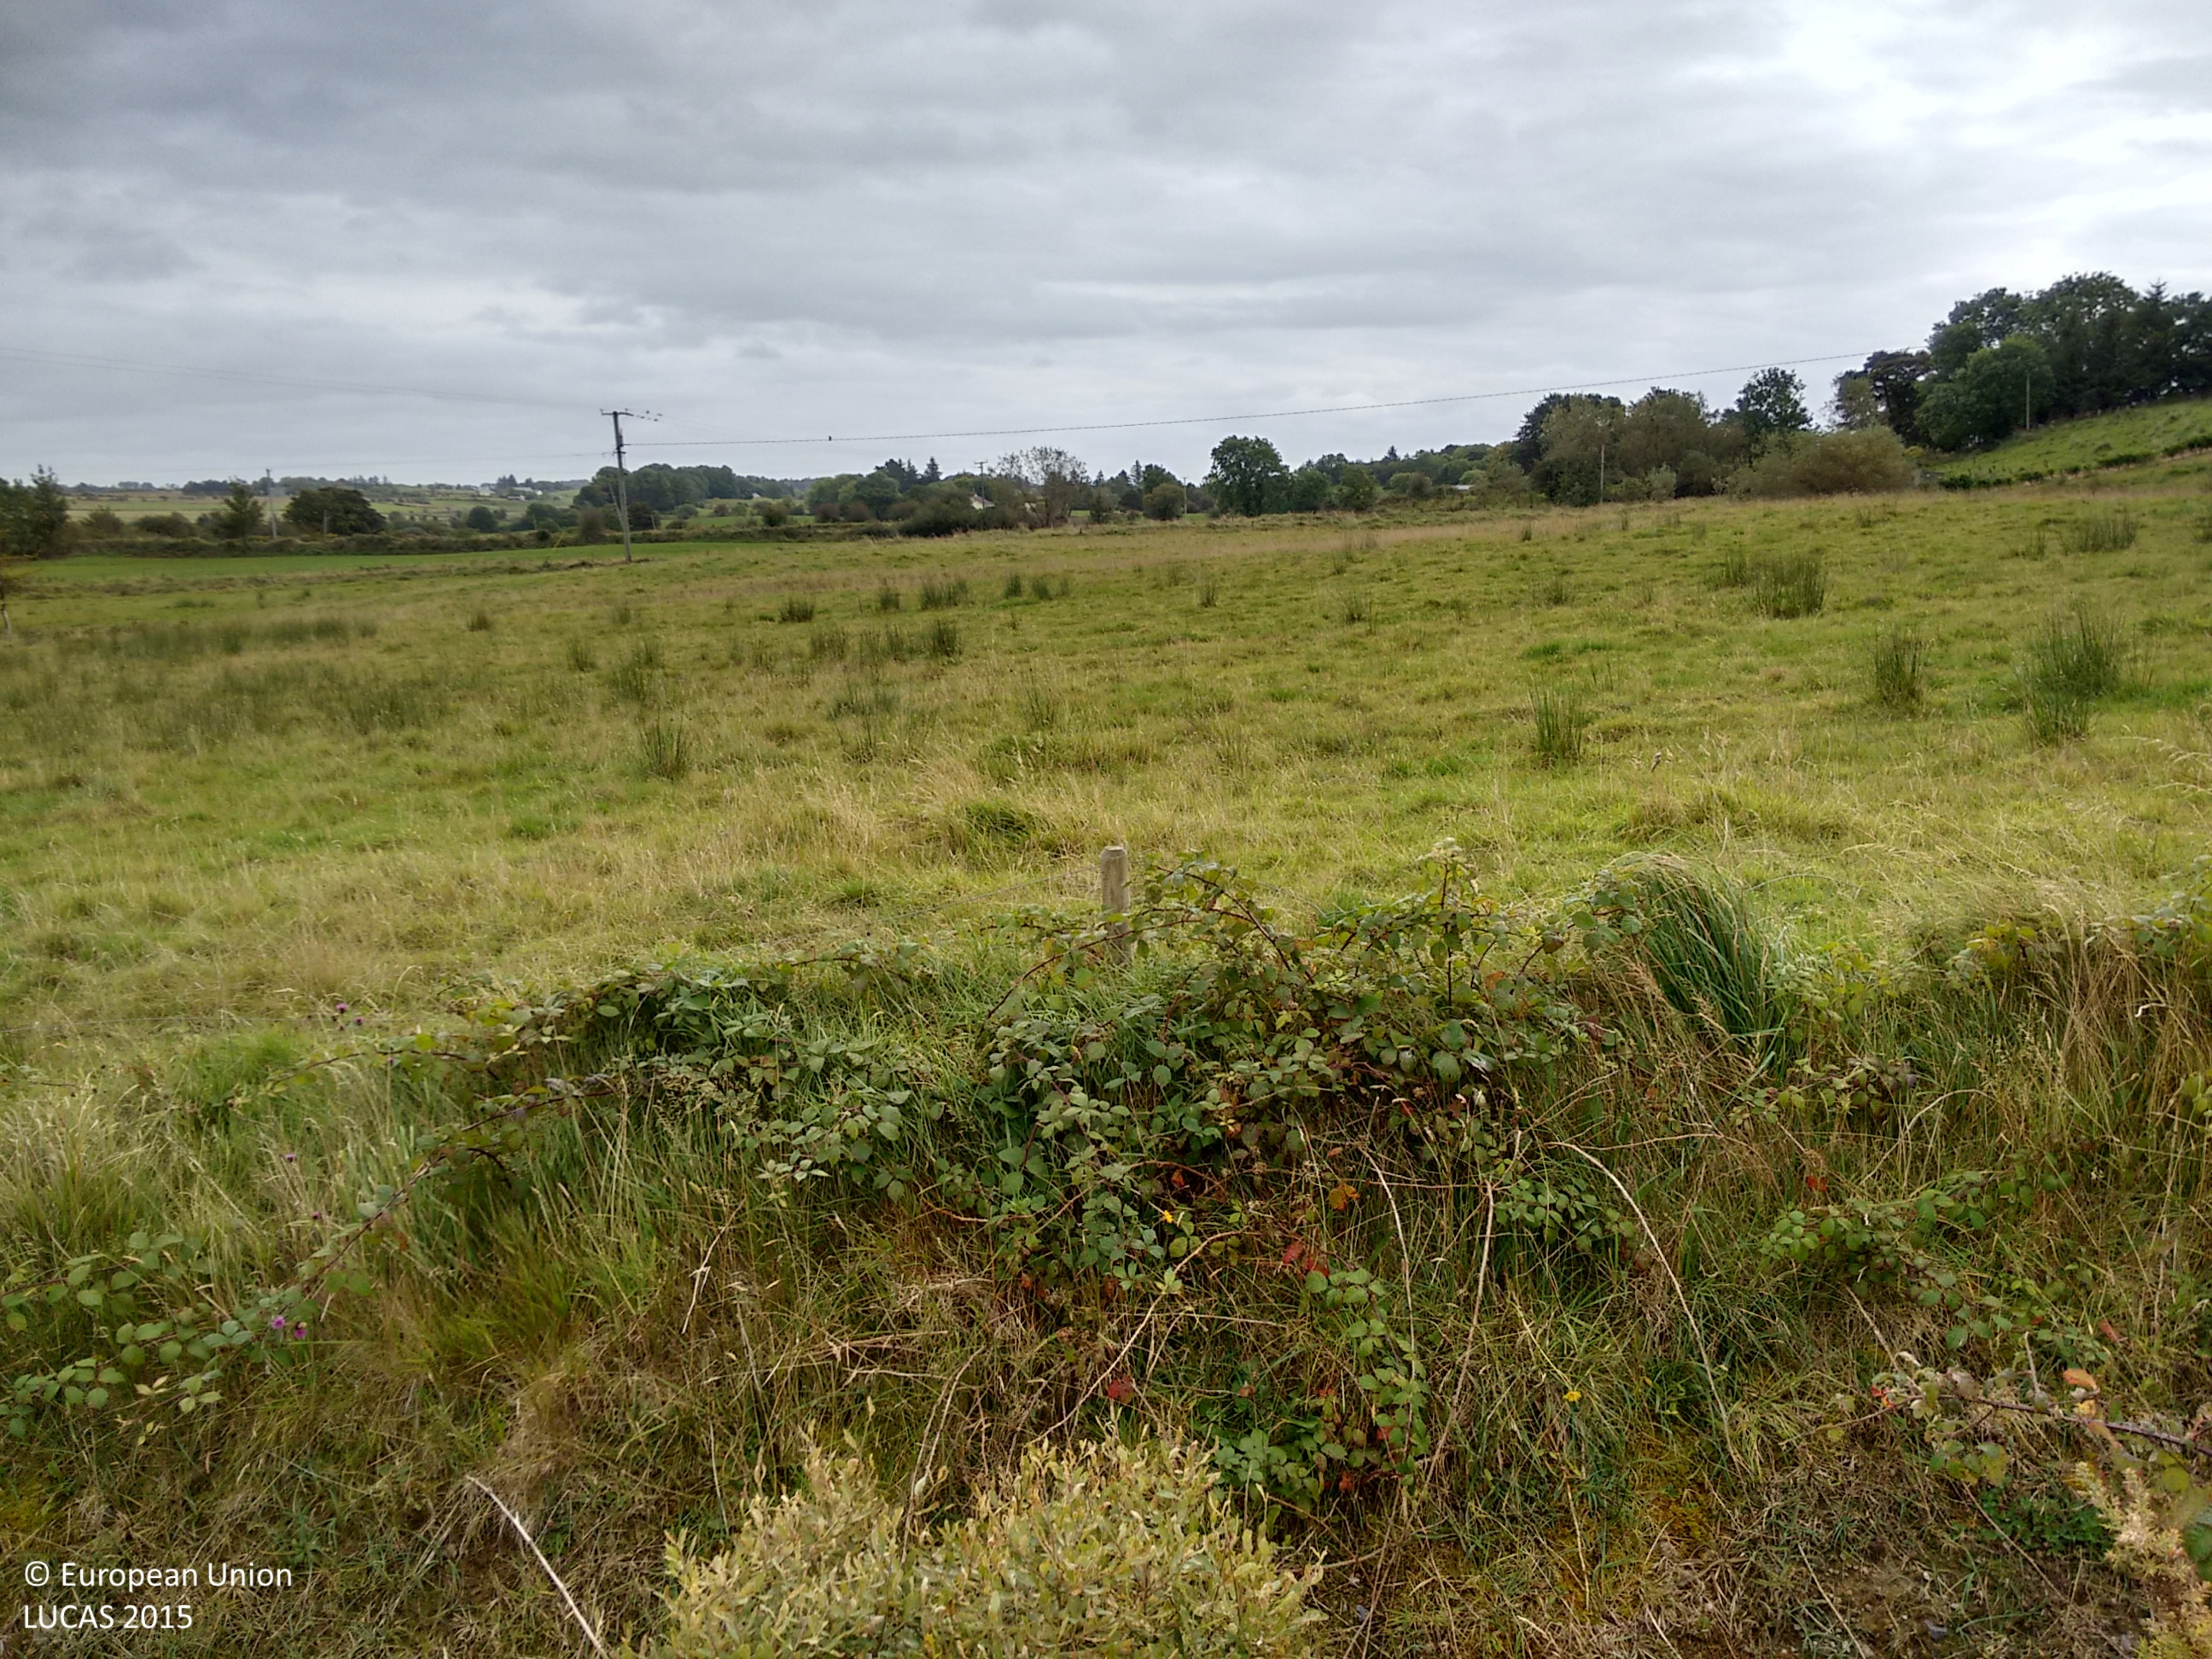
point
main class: Grassland
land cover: Grassland without tree/shrub cover
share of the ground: > 75 %
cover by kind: herbaceous plants 100 %
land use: Agriculture (excluding fallow land and kitchen gardens)
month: September
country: IE
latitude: 53.8386
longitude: -8.8843
